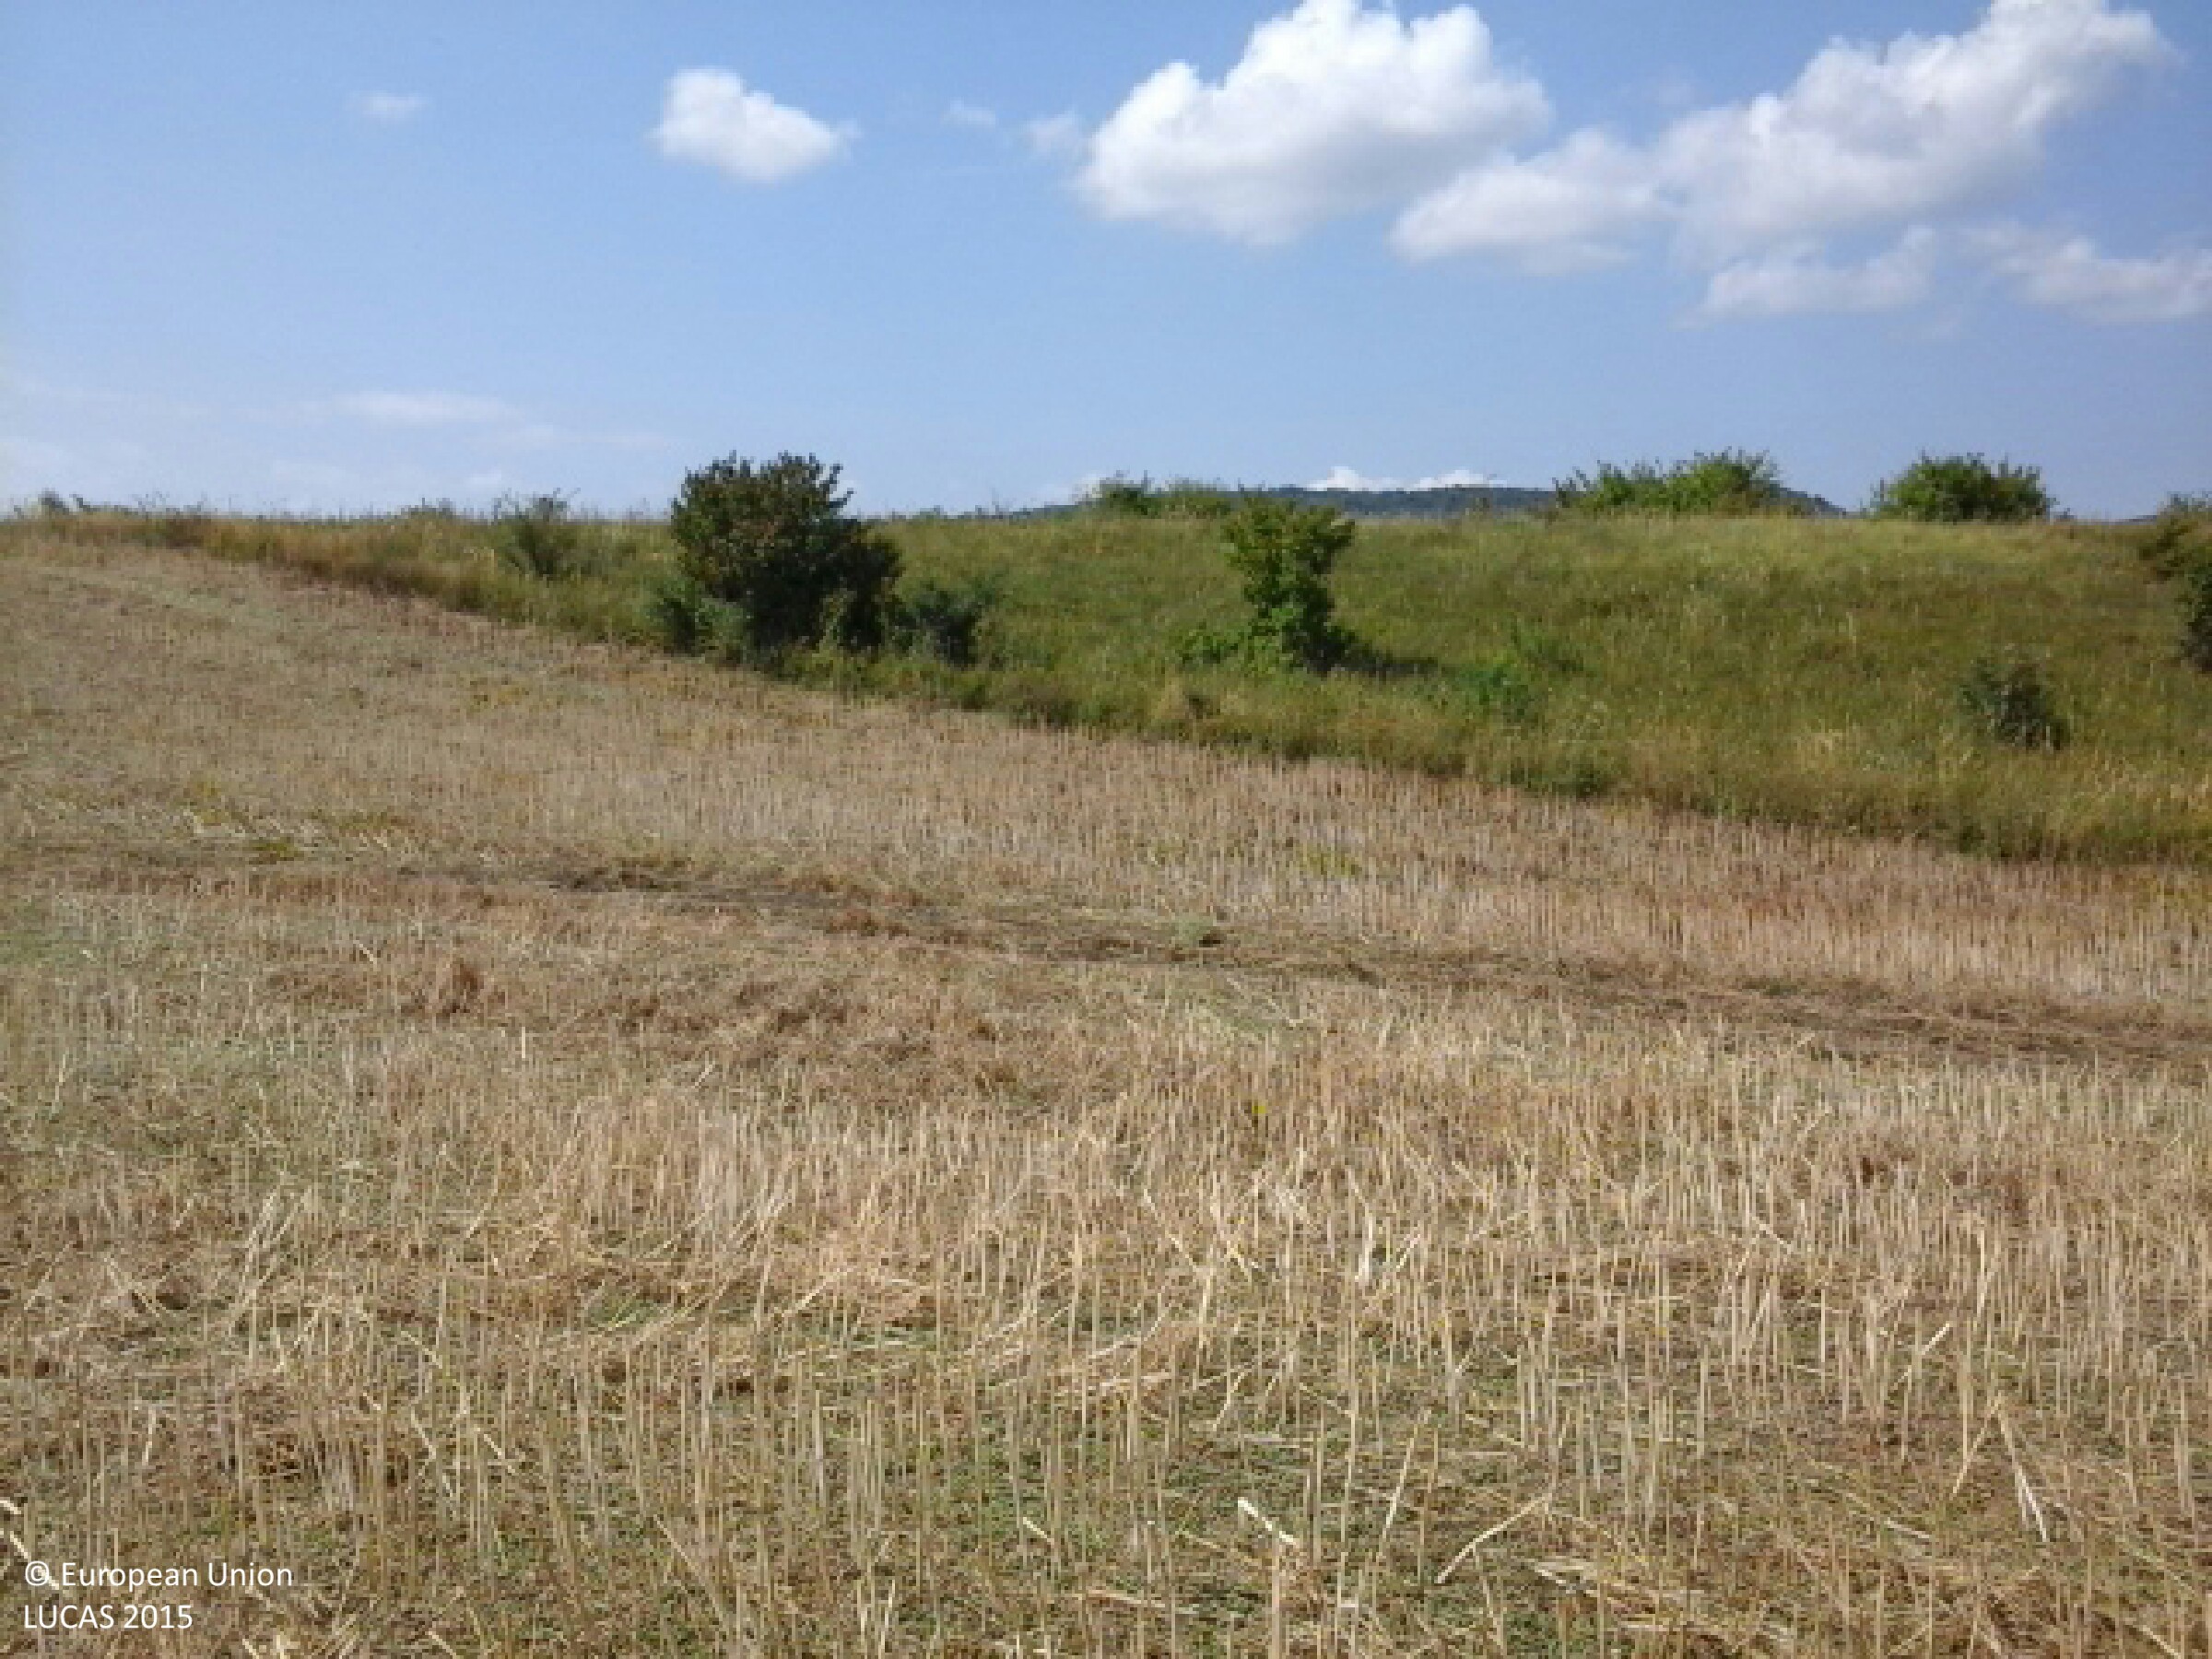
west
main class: Cropland
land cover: Rape and turnip rape
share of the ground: 10 - 25 %
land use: Agriculture (excluding fallow land and kitchen gardens)
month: August
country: HU
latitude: 47.5822
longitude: 18.5638
